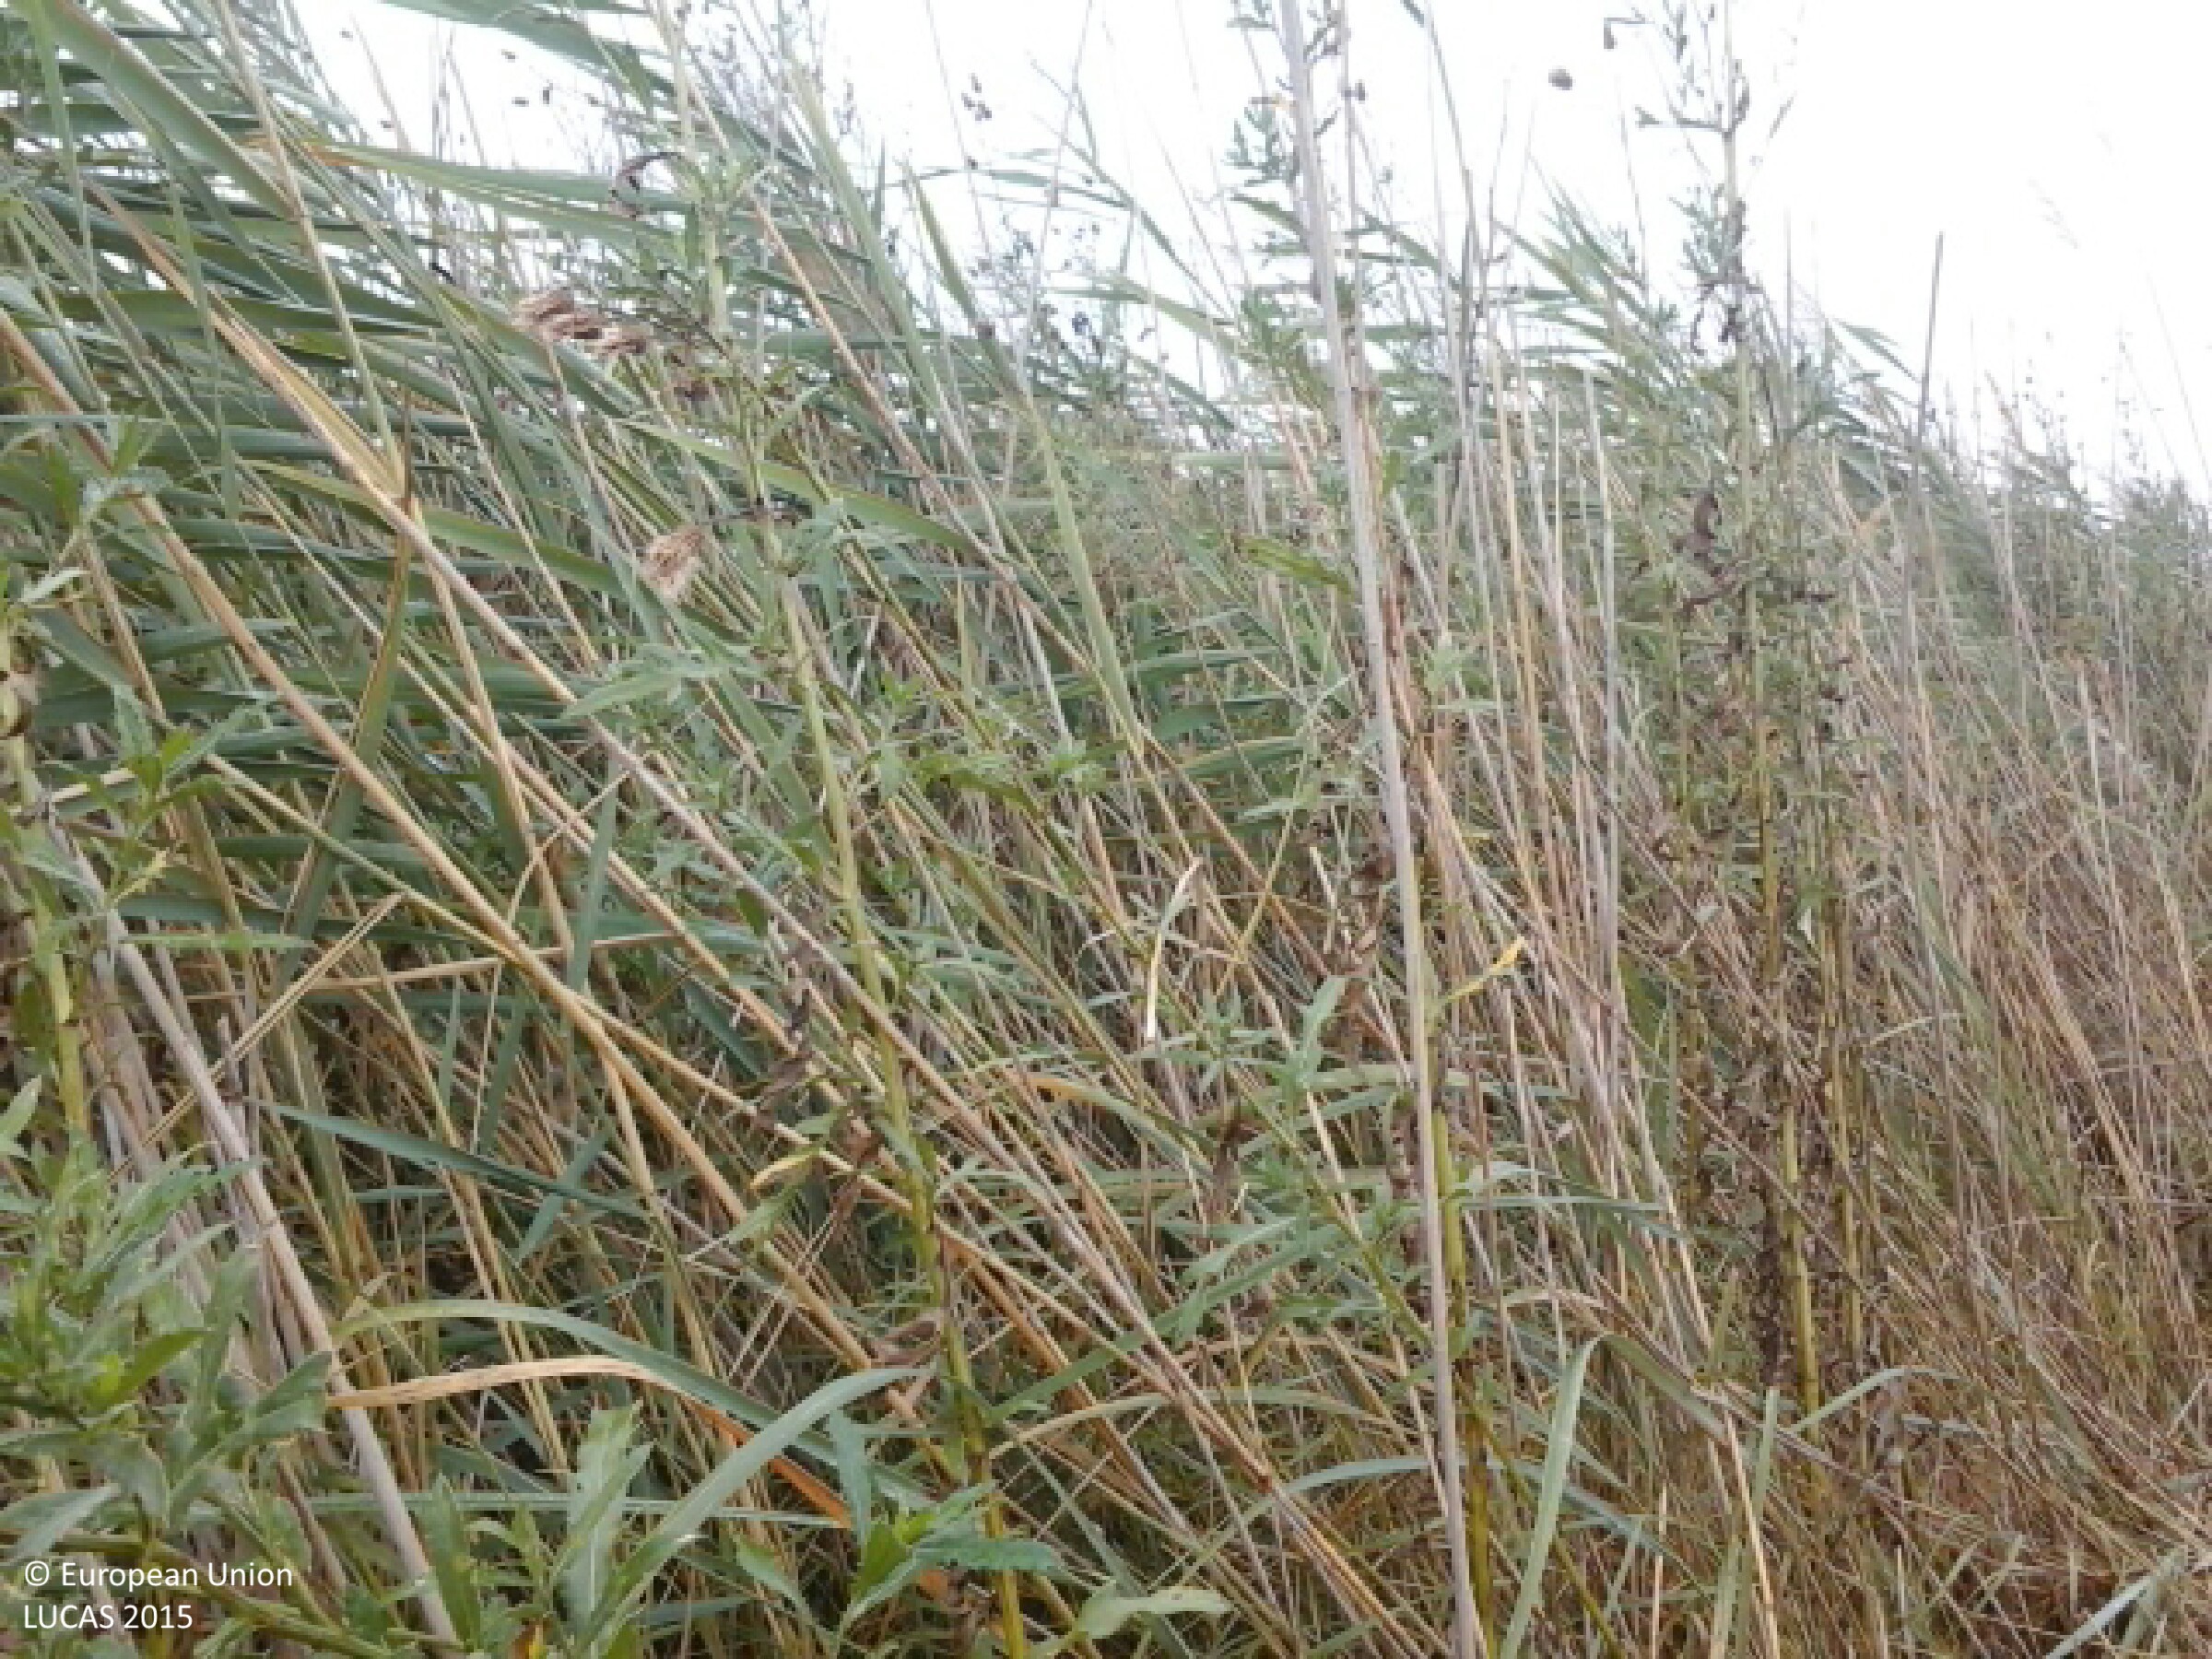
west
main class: Grassland
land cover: Grassland without tree/shrub cover
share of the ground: > 75 %
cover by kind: herbaceous plants 100 %
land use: Agriculture (excluding fallow land and kitchen gardens)
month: August
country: HU
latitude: 48.0390
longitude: 21.4861
